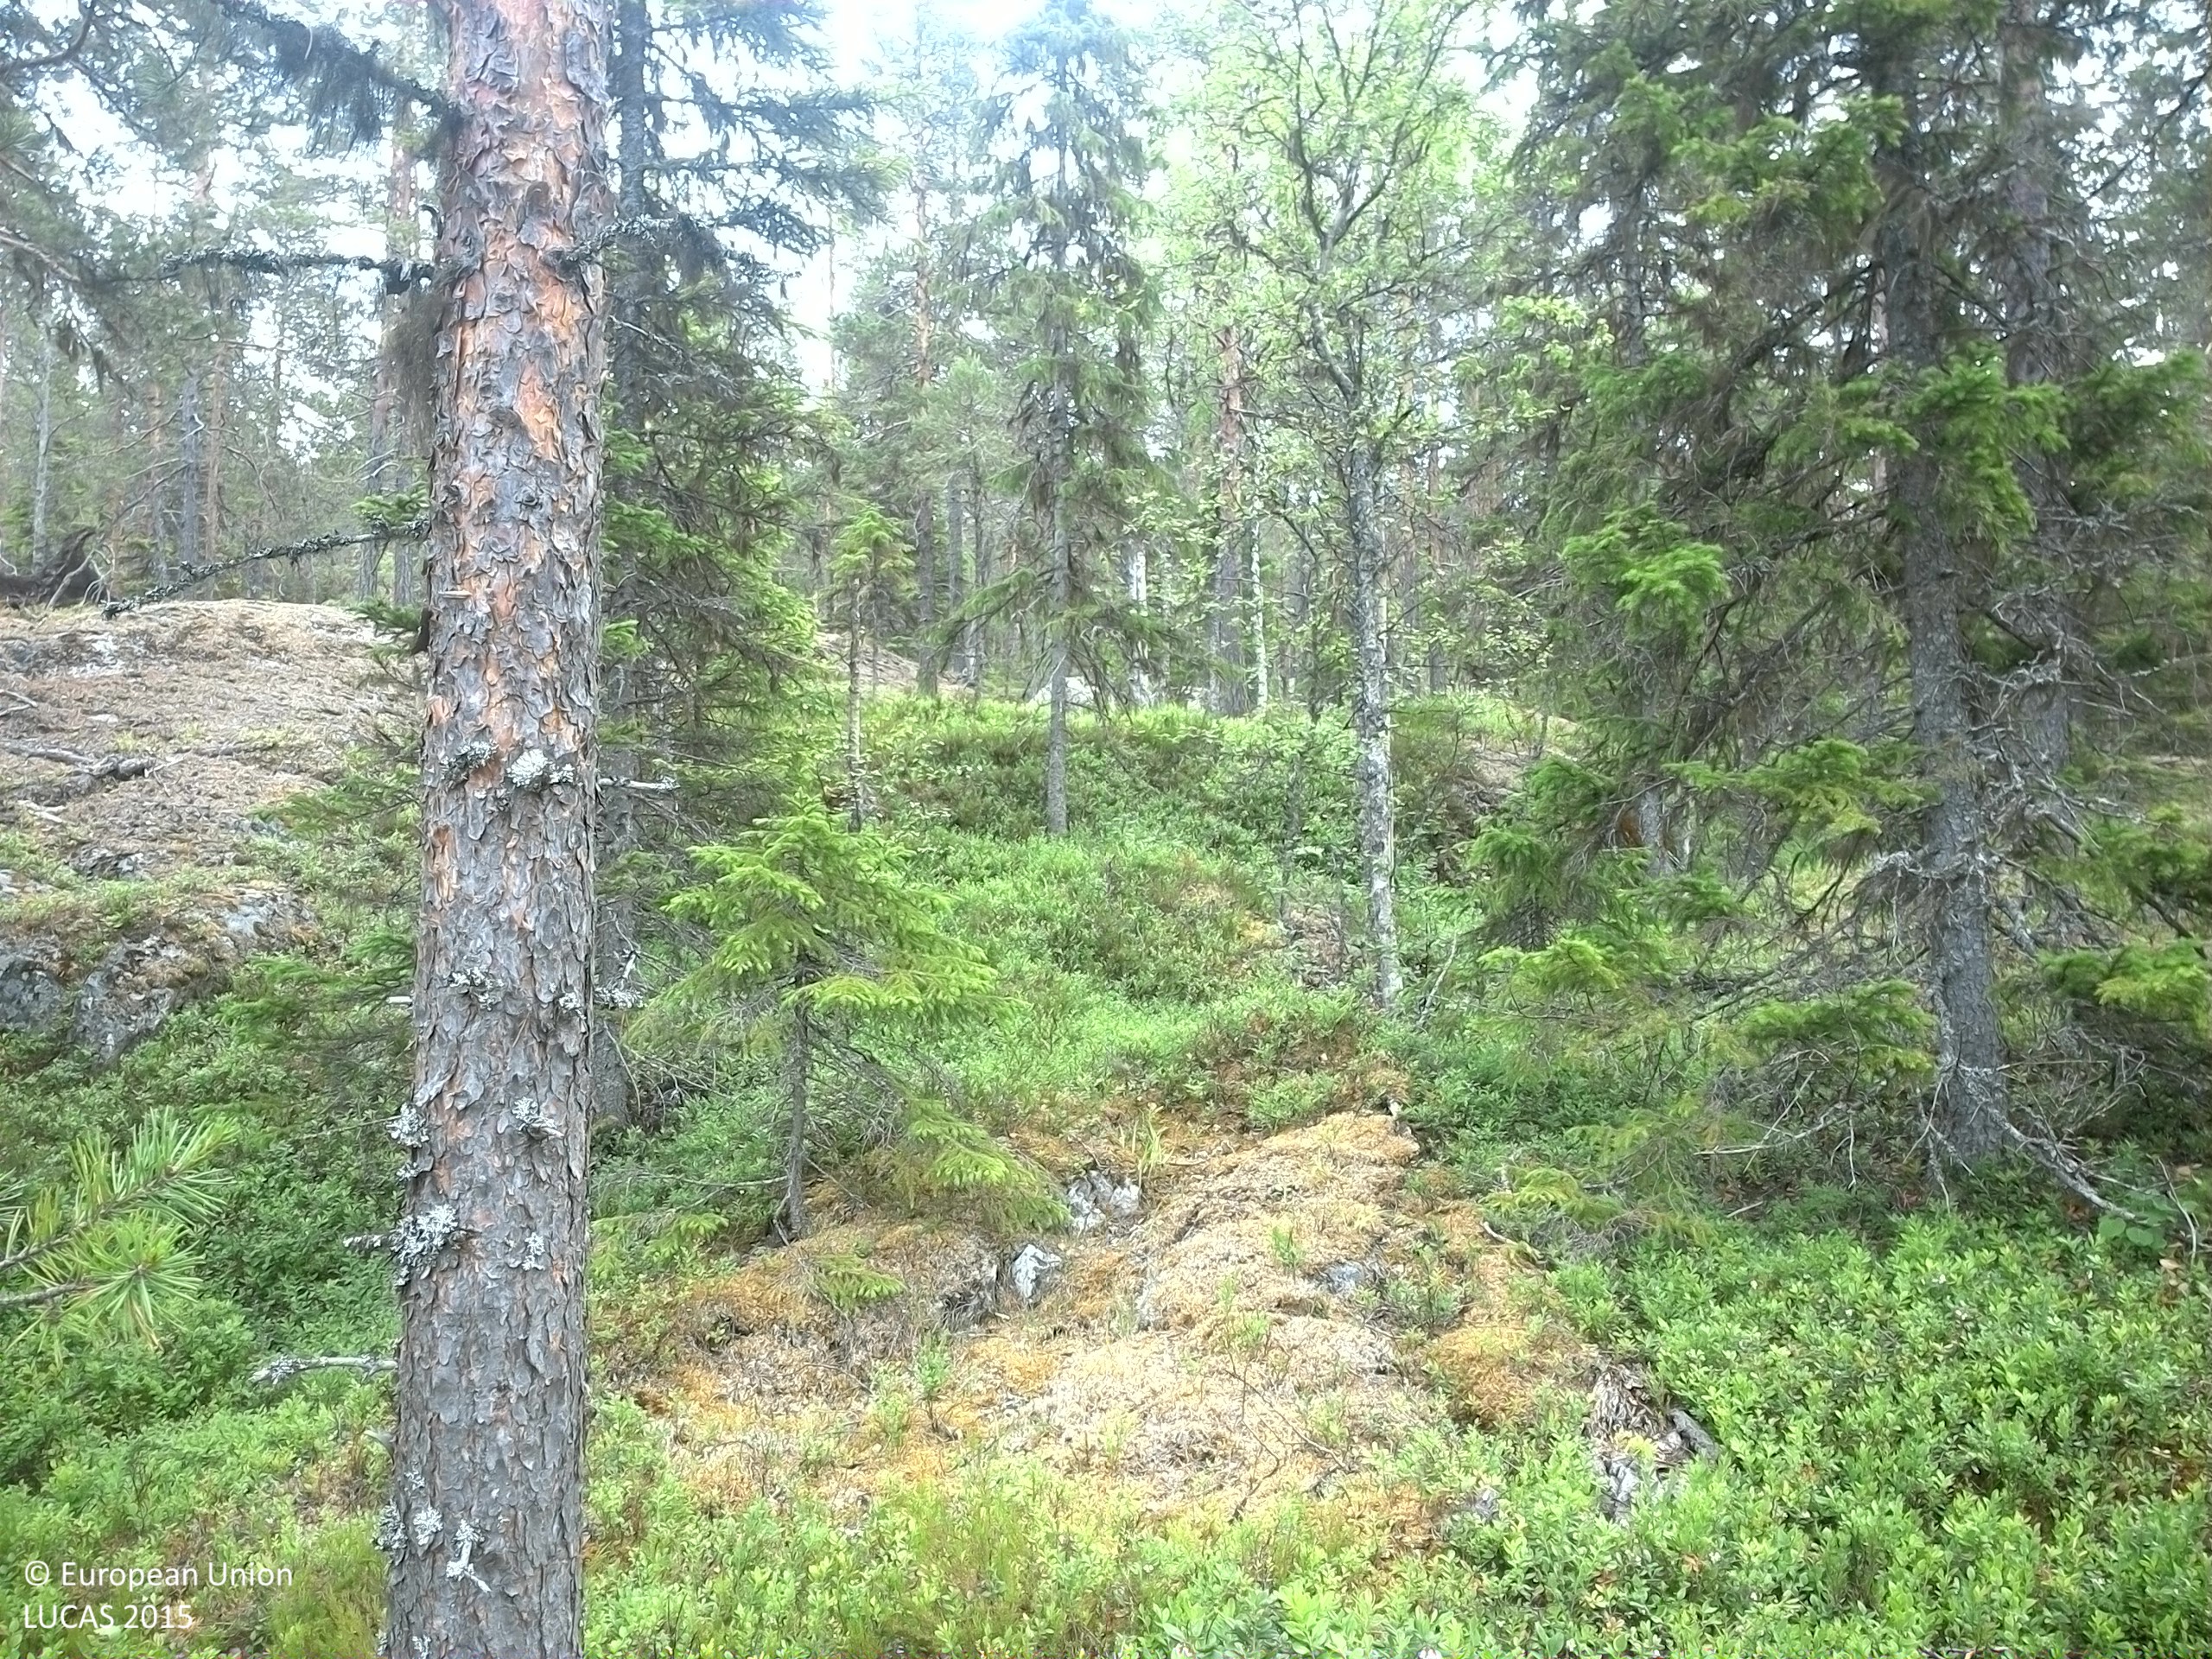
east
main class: Woodland
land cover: Pine dominated mixed woodland
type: boreal forest
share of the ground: 50 - 75 %
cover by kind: coniferous forest trees 45 %, shrubs 20 %, broadleaved forest trees 15 %, lichens and mosses 10 %, consolidated bare surface 10 %
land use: Forestry
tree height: > 5 m
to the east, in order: Pine dominated mixed woodland; Pine dominated coniferous woodland
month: July
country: SE
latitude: 63.5665
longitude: 17.8870
